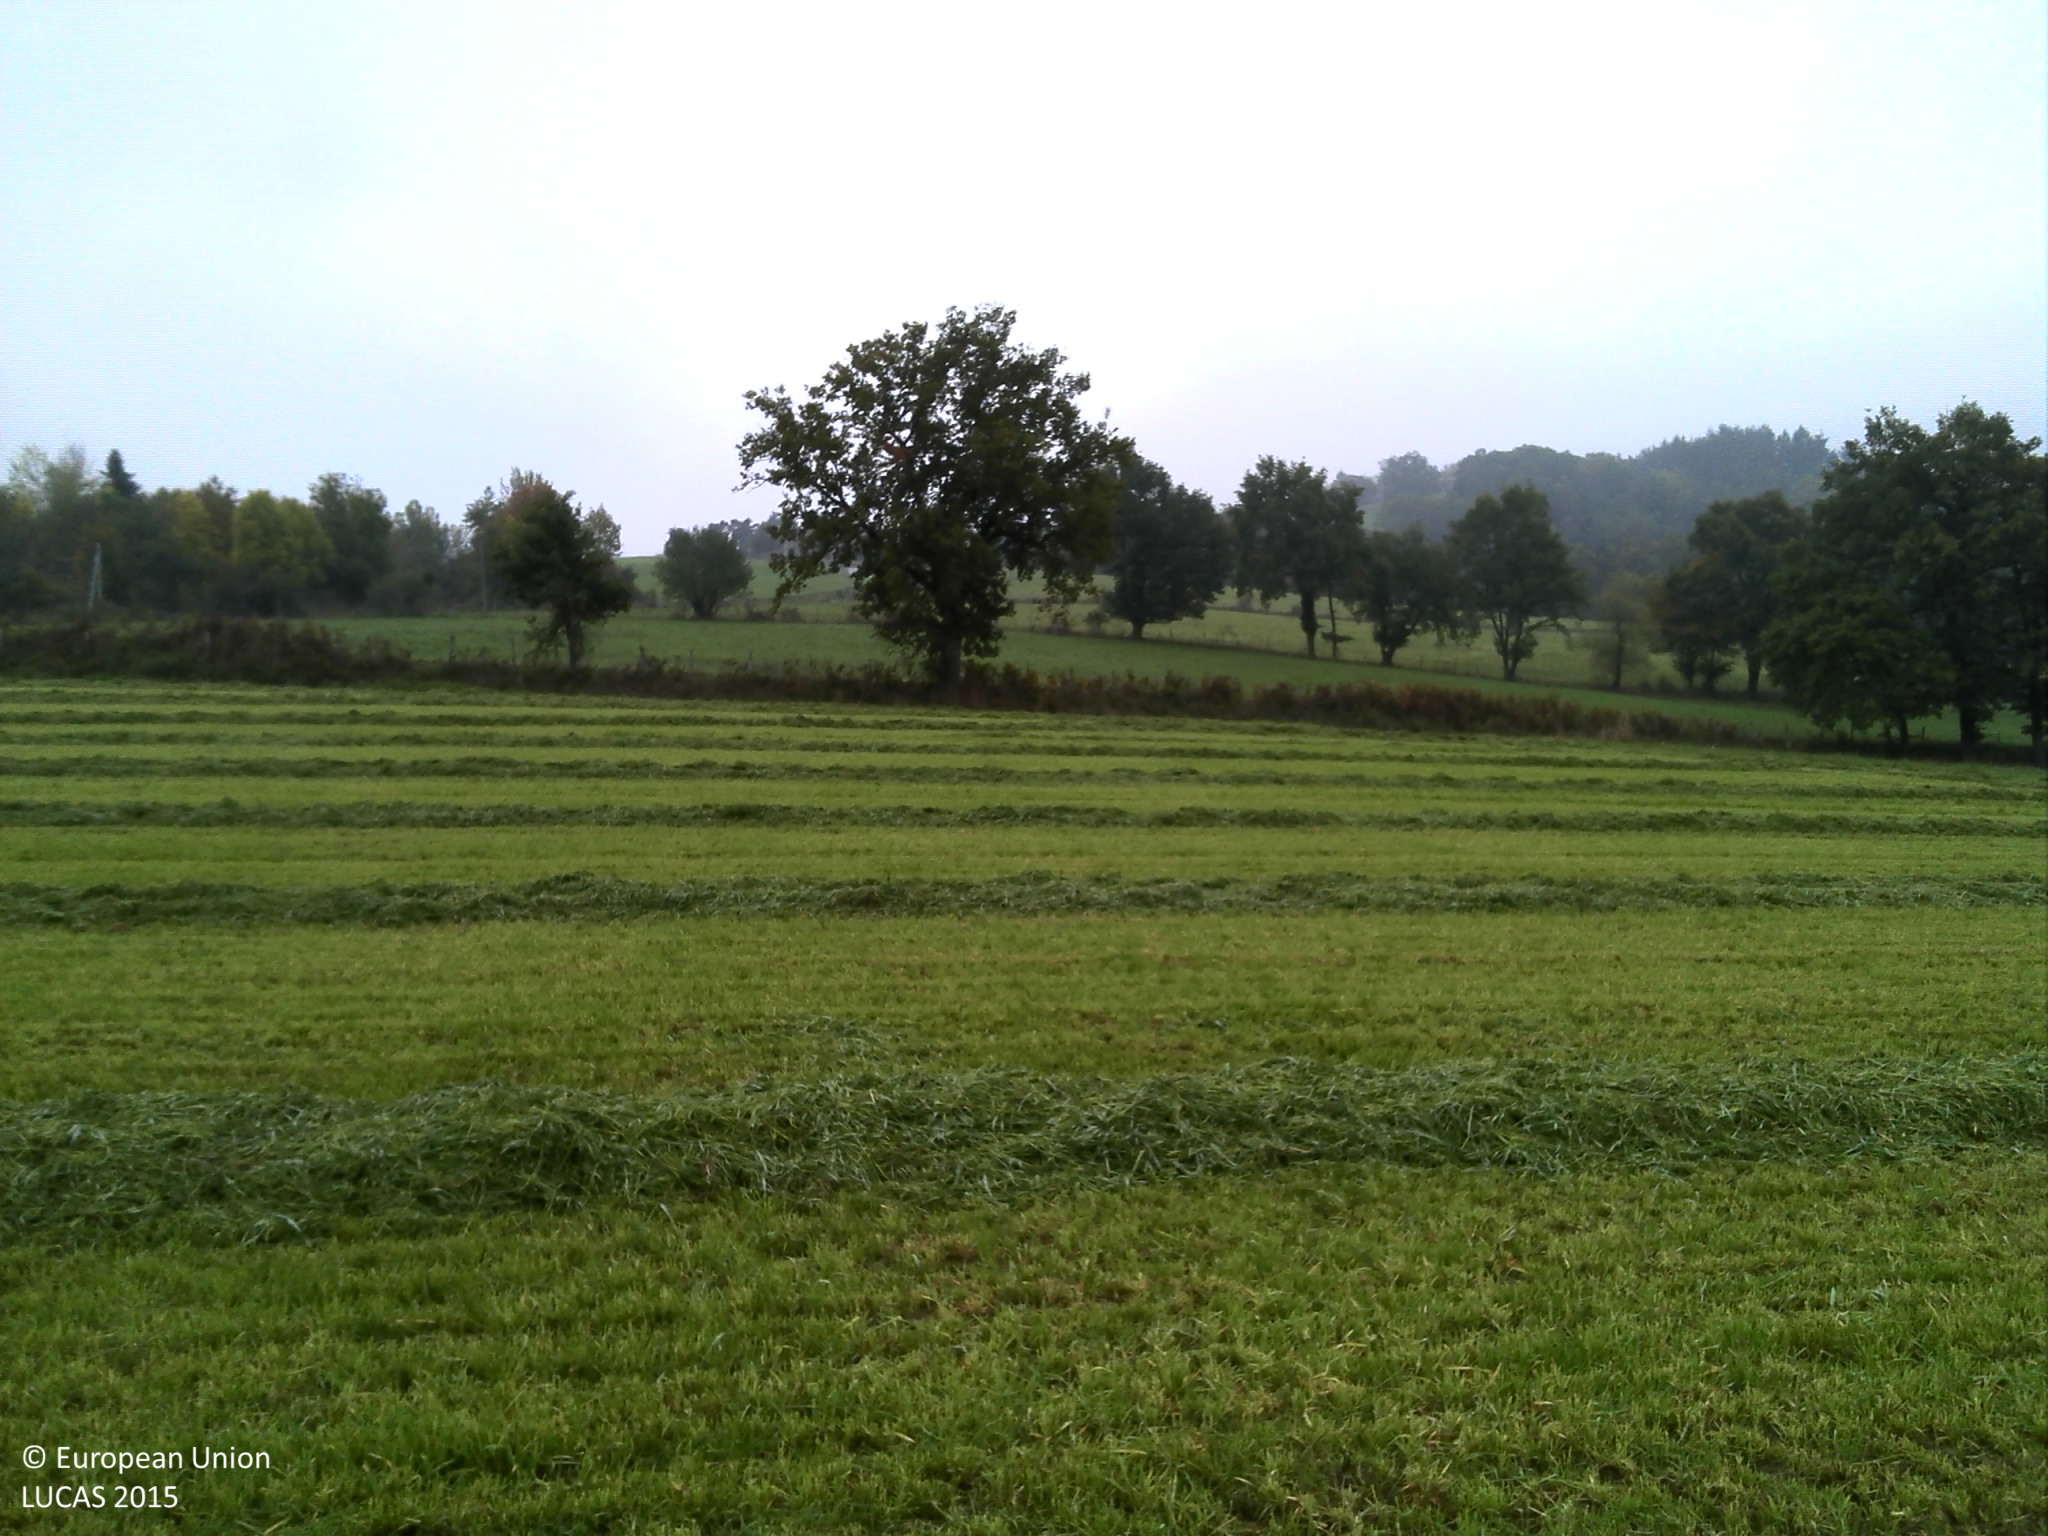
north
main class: Cropland
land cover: Temporary grasslands
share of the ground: > 75 %
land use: Agriculture (excluding fallow land and kitchen gardens)
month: October
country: FR
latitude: 45.6066
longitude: 3.4237
